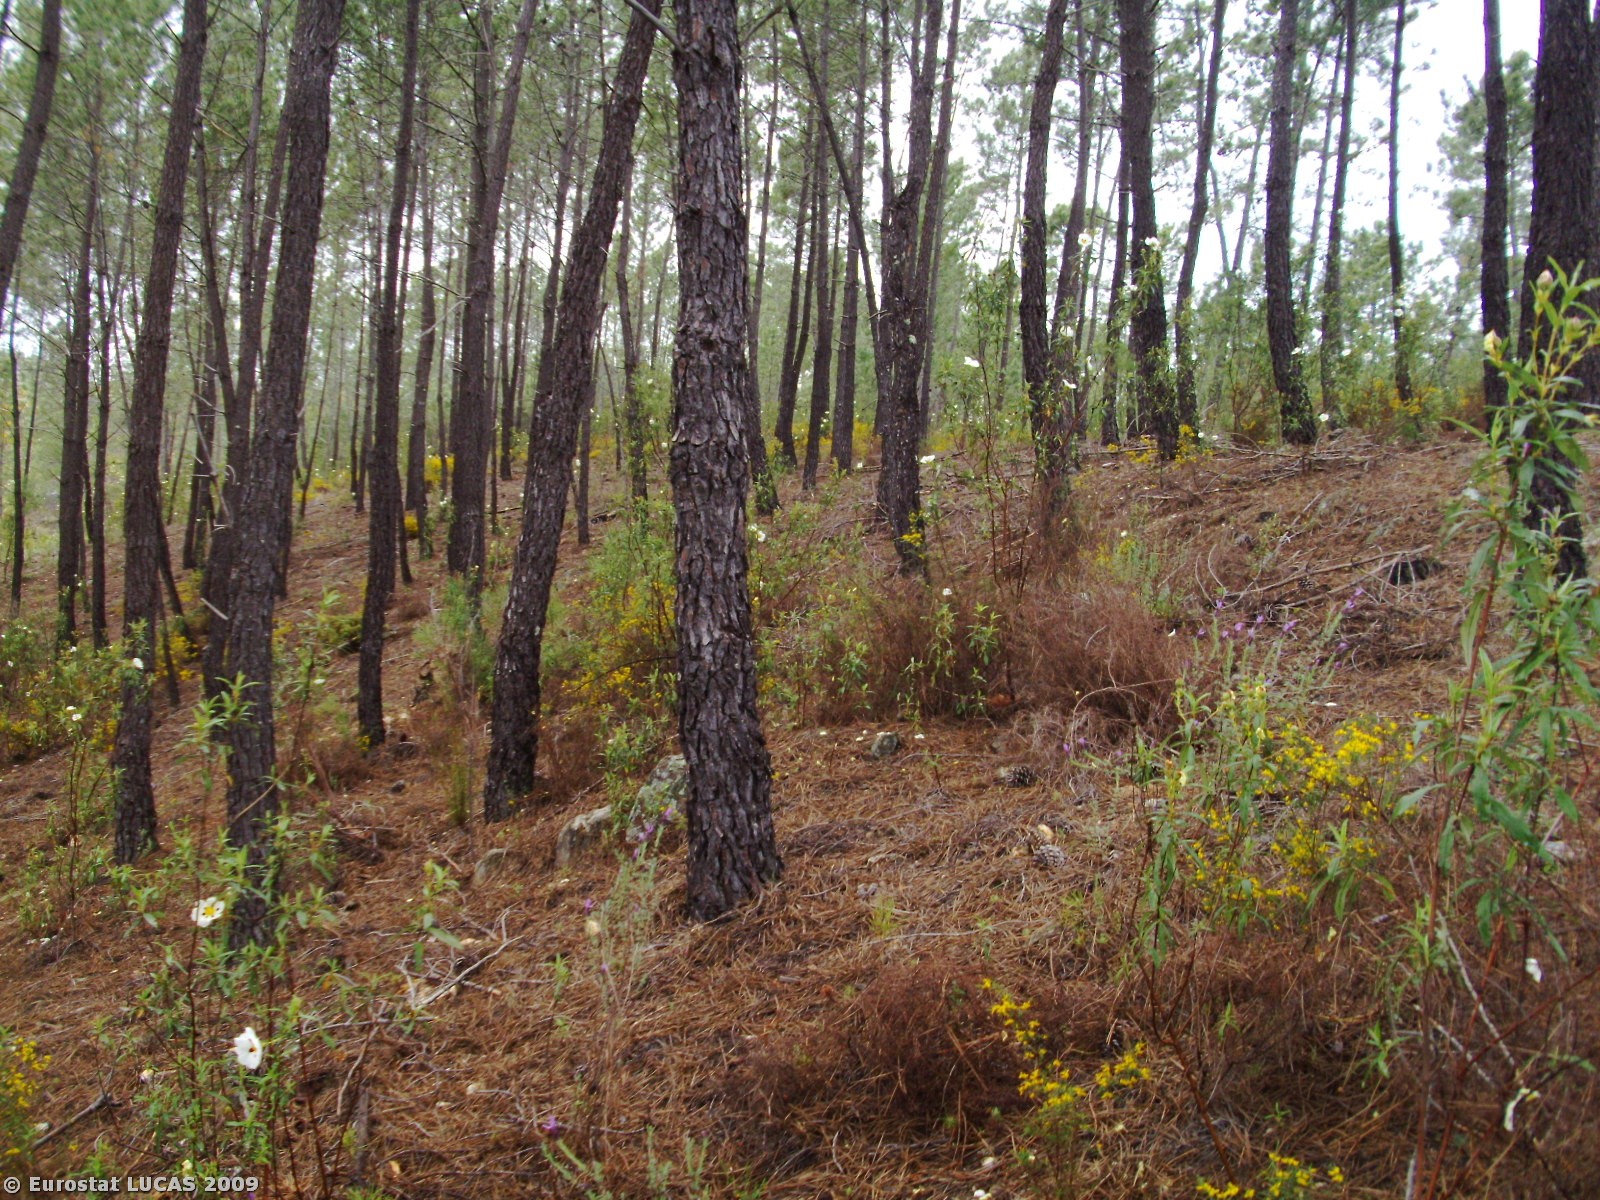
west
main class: Woodland
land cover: Coniferous woodland
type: coniferous forest of the mediterranean region
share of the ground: 50 - 75 %
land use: Forestry
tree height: > 5 m
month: April
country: PT
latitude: 39.8443
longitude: -7.5971
